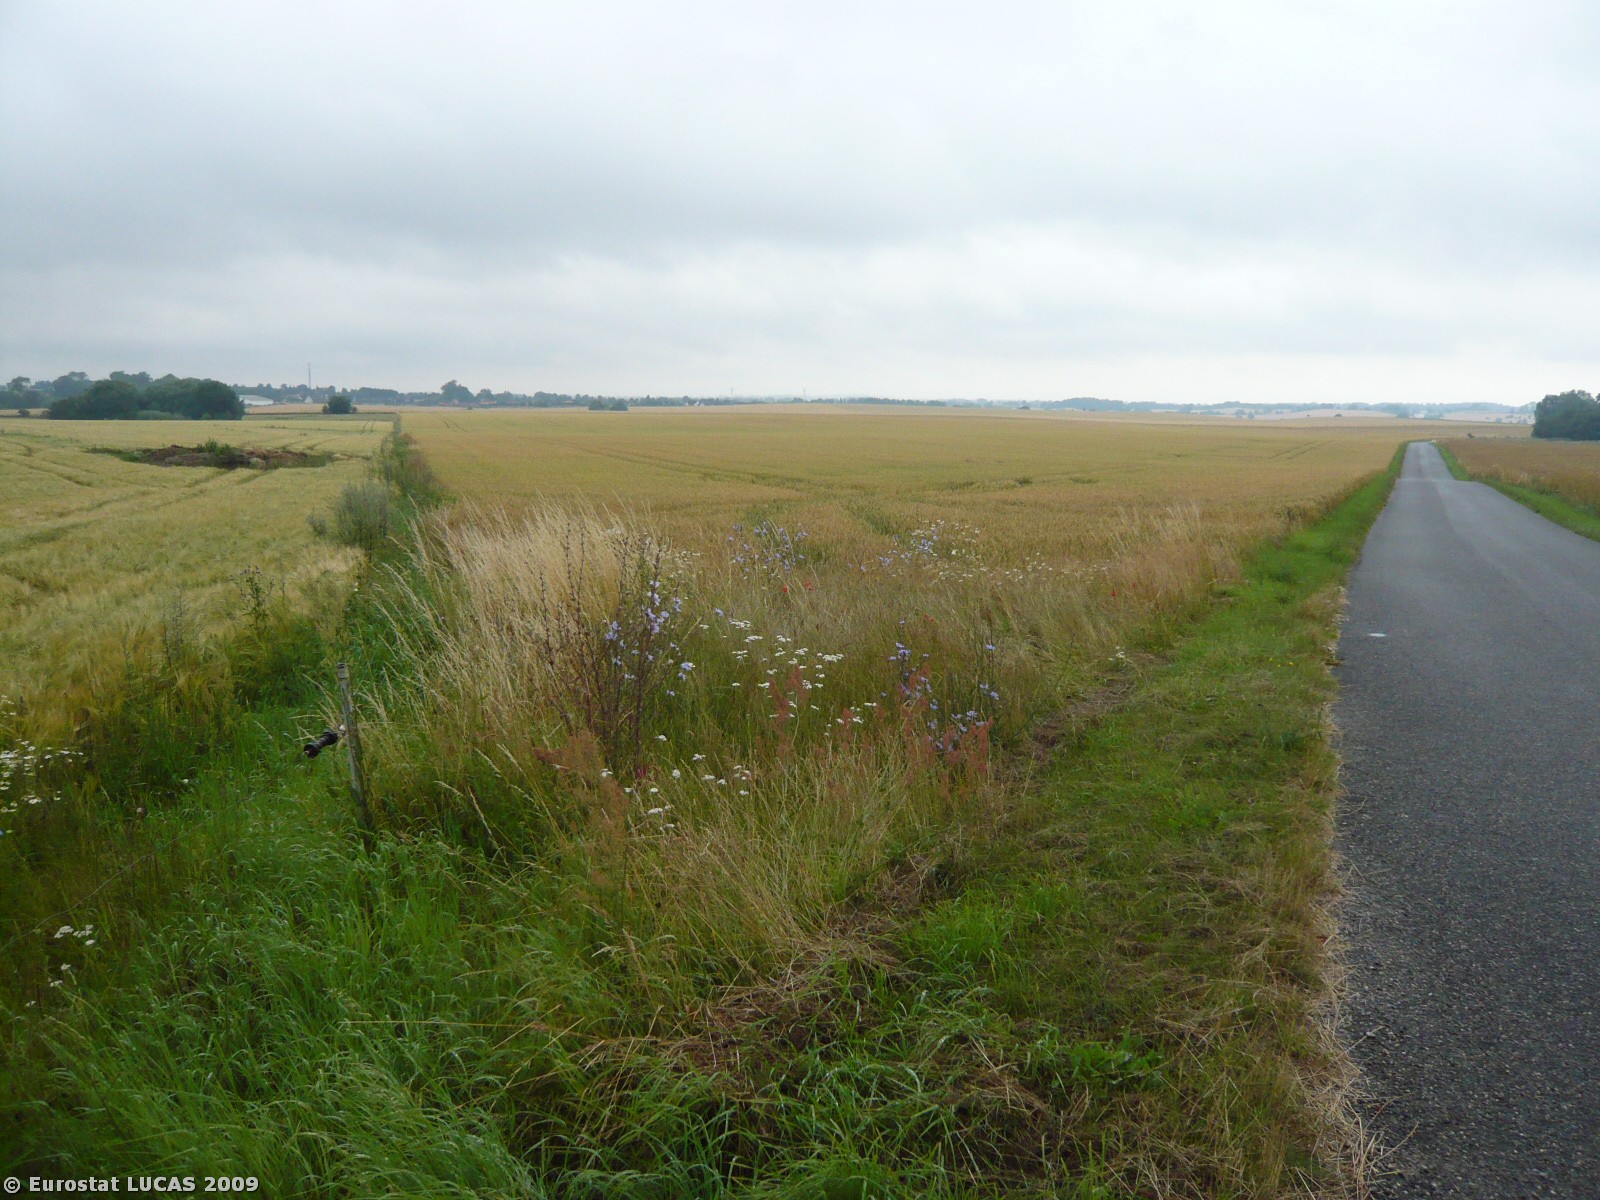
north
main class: Cropland
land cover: Common wheat
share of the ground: > 75 %
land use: Agriculture (excluding fallow land and kitchen gardens)
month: July
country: DK
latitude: 55.6884
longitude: 11.8912
